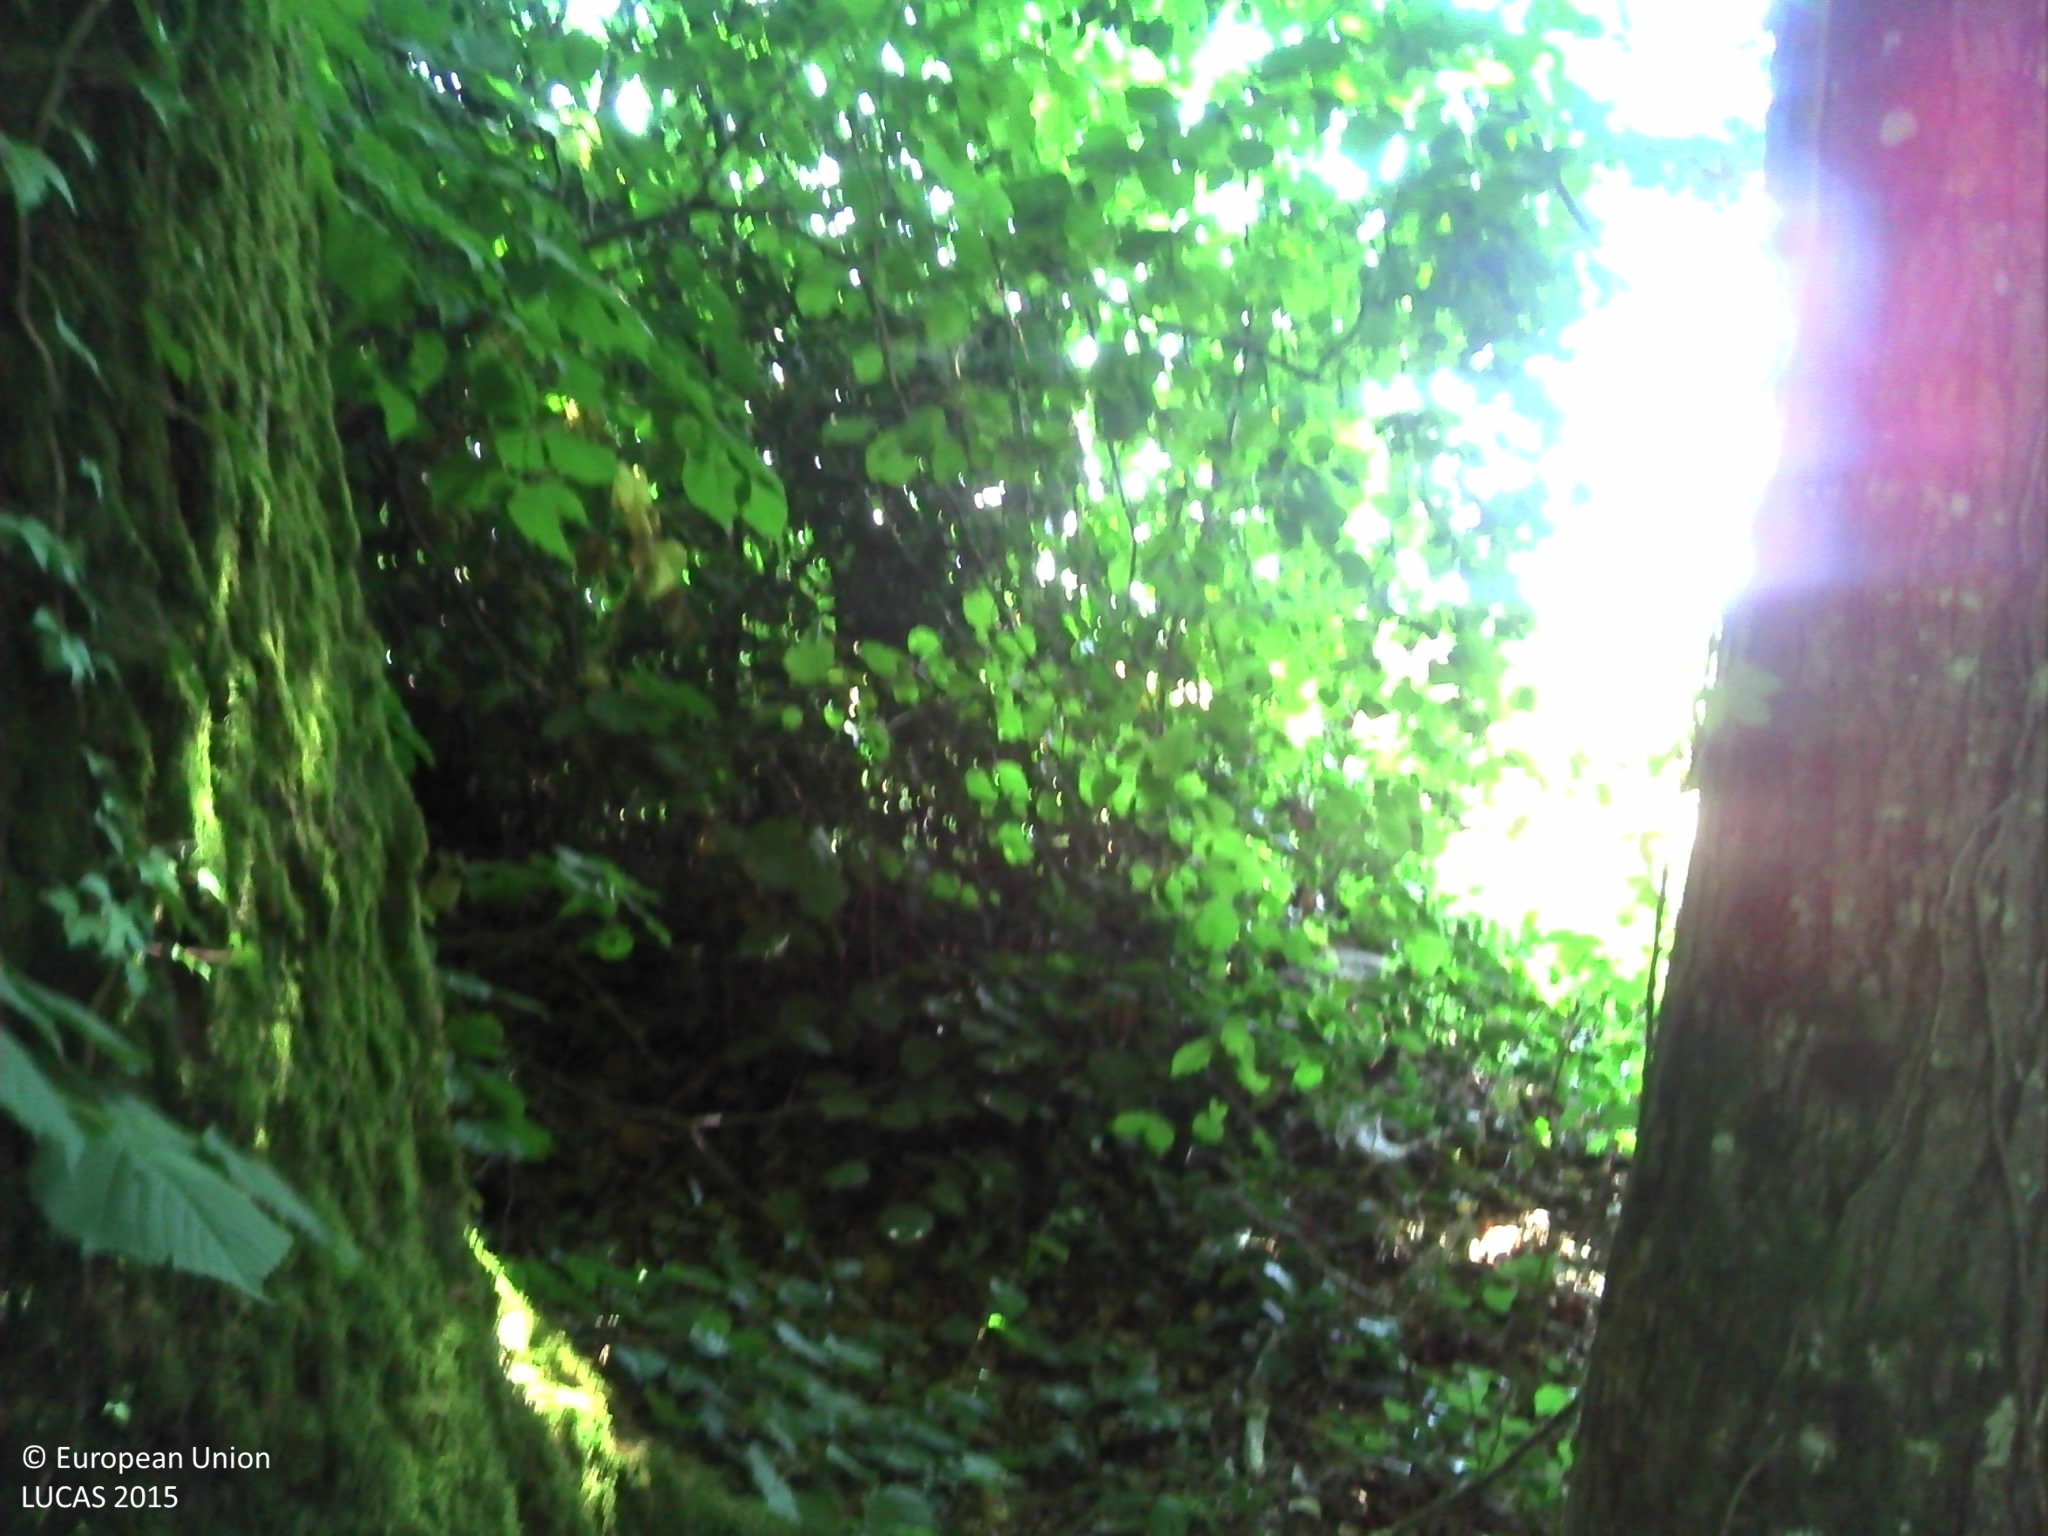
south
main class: Woodland
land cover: Broadleaved woodland
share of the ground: > 75 %
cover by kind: broadleaved forest trees 40 %, herbaceous plants 20 %, lichens and mosses 20 %, unconsolidated bare surface 20 %
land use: Forestry
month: July
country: FR
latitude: 45.6446
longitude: 0.9957
